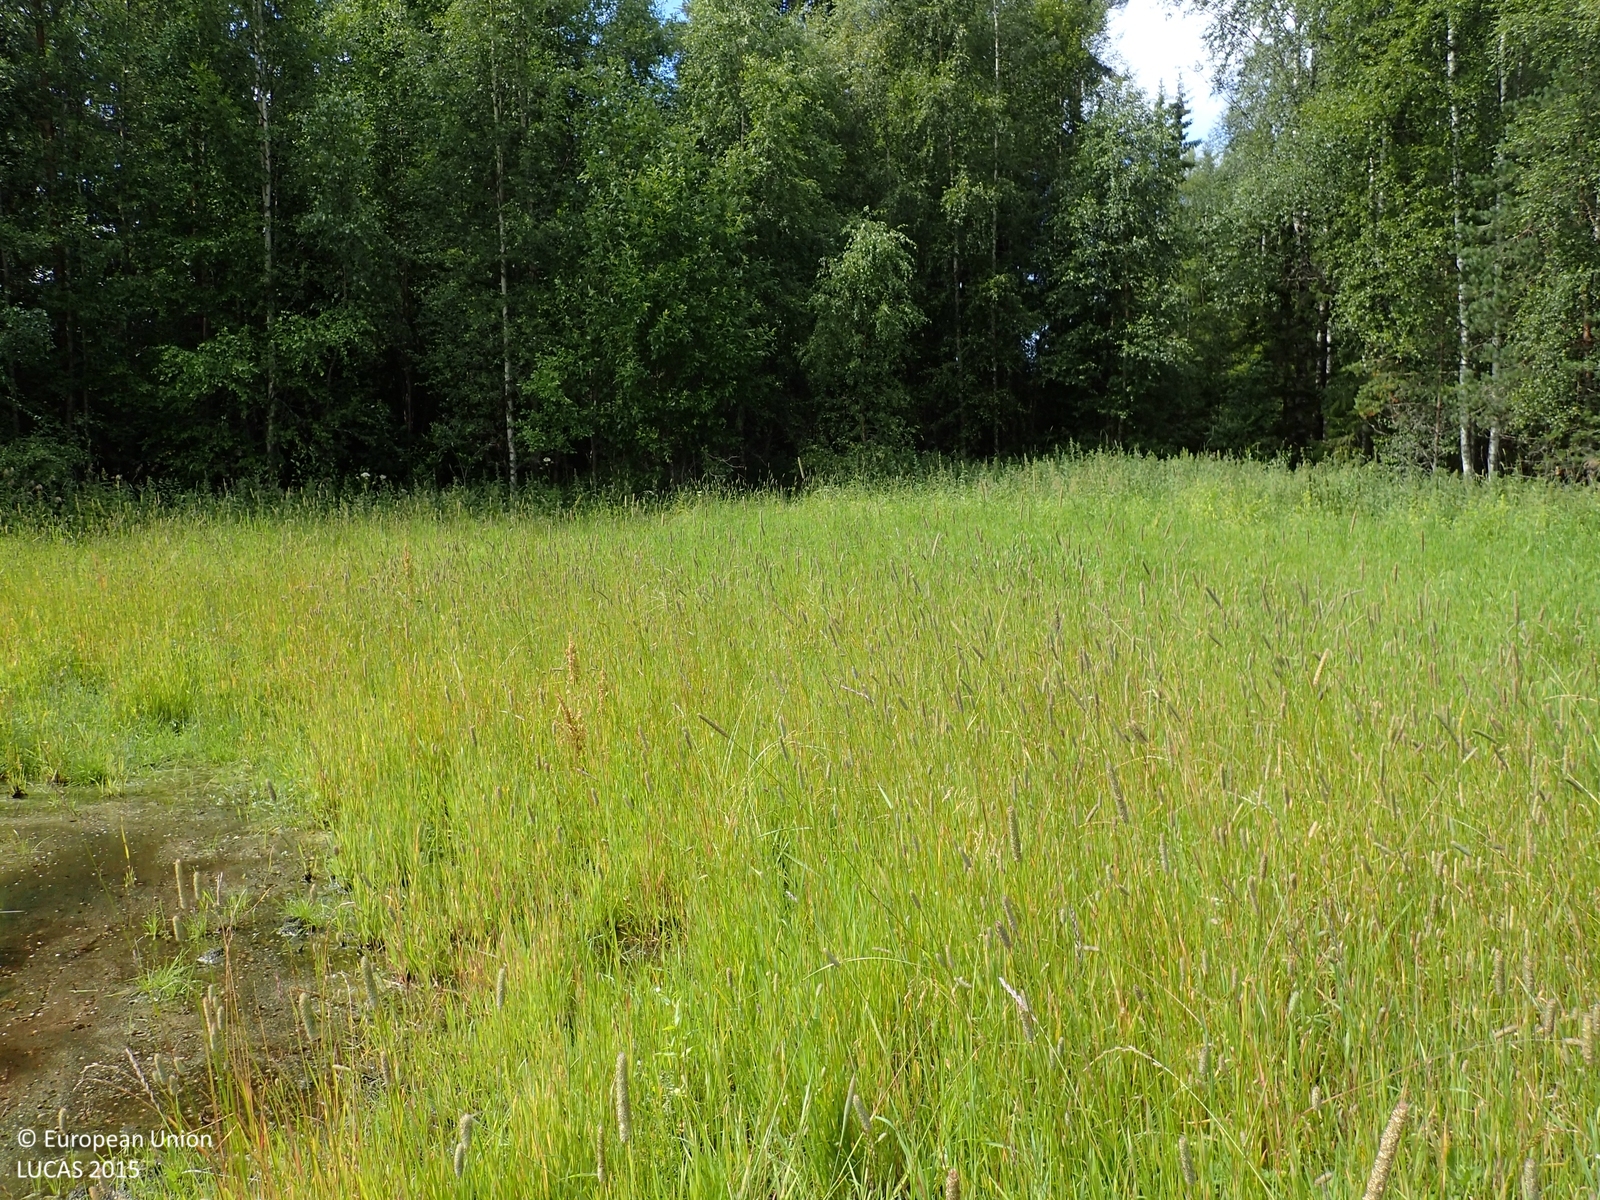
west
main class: Grassland
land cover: Spontaneously vegetated surfaces
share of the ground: > 75 %
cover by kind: herbaceous plants 100 %
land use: Fallow land
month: August
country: FI
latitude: 62.8374
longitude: 21.8451
